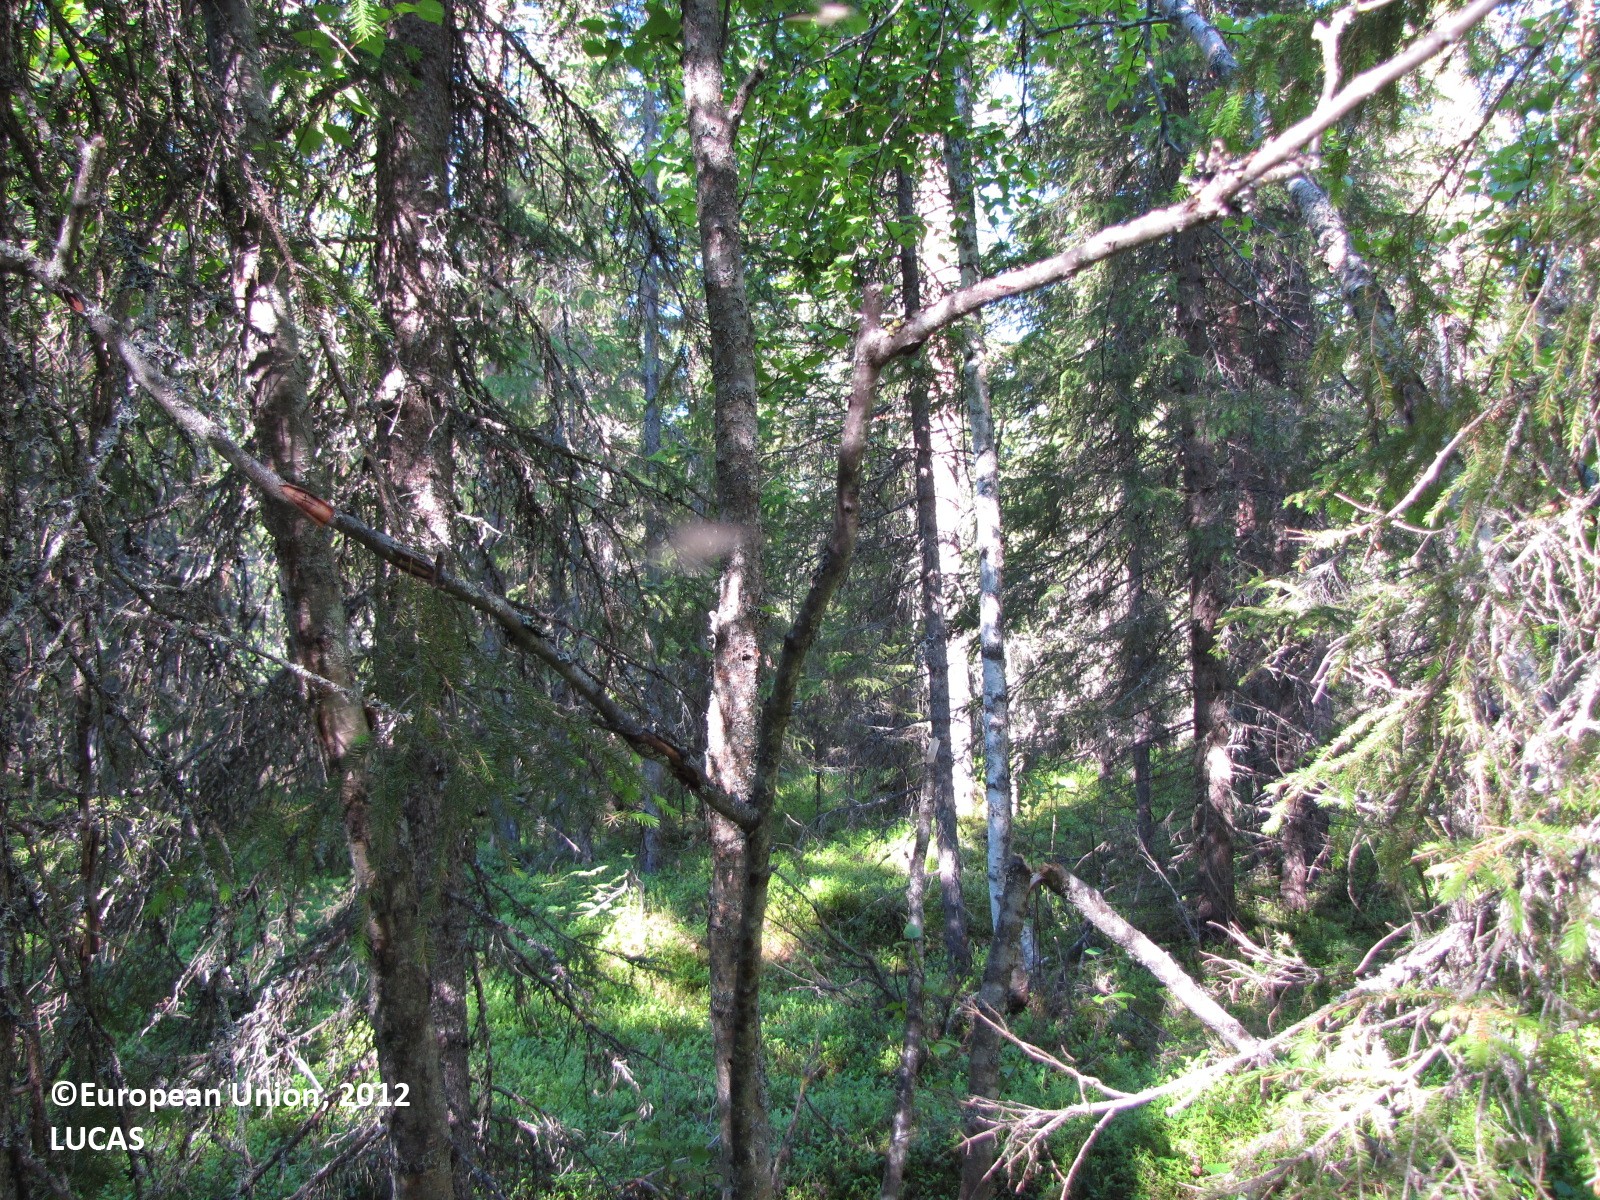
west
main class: Woodland
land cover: Spruce dominated coniferous woodland
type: boreal forest
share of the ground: 50 - 75 %
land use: Forestry
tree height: > 5 m
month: July
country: FI
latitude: 66.4170
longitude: 24.7670
